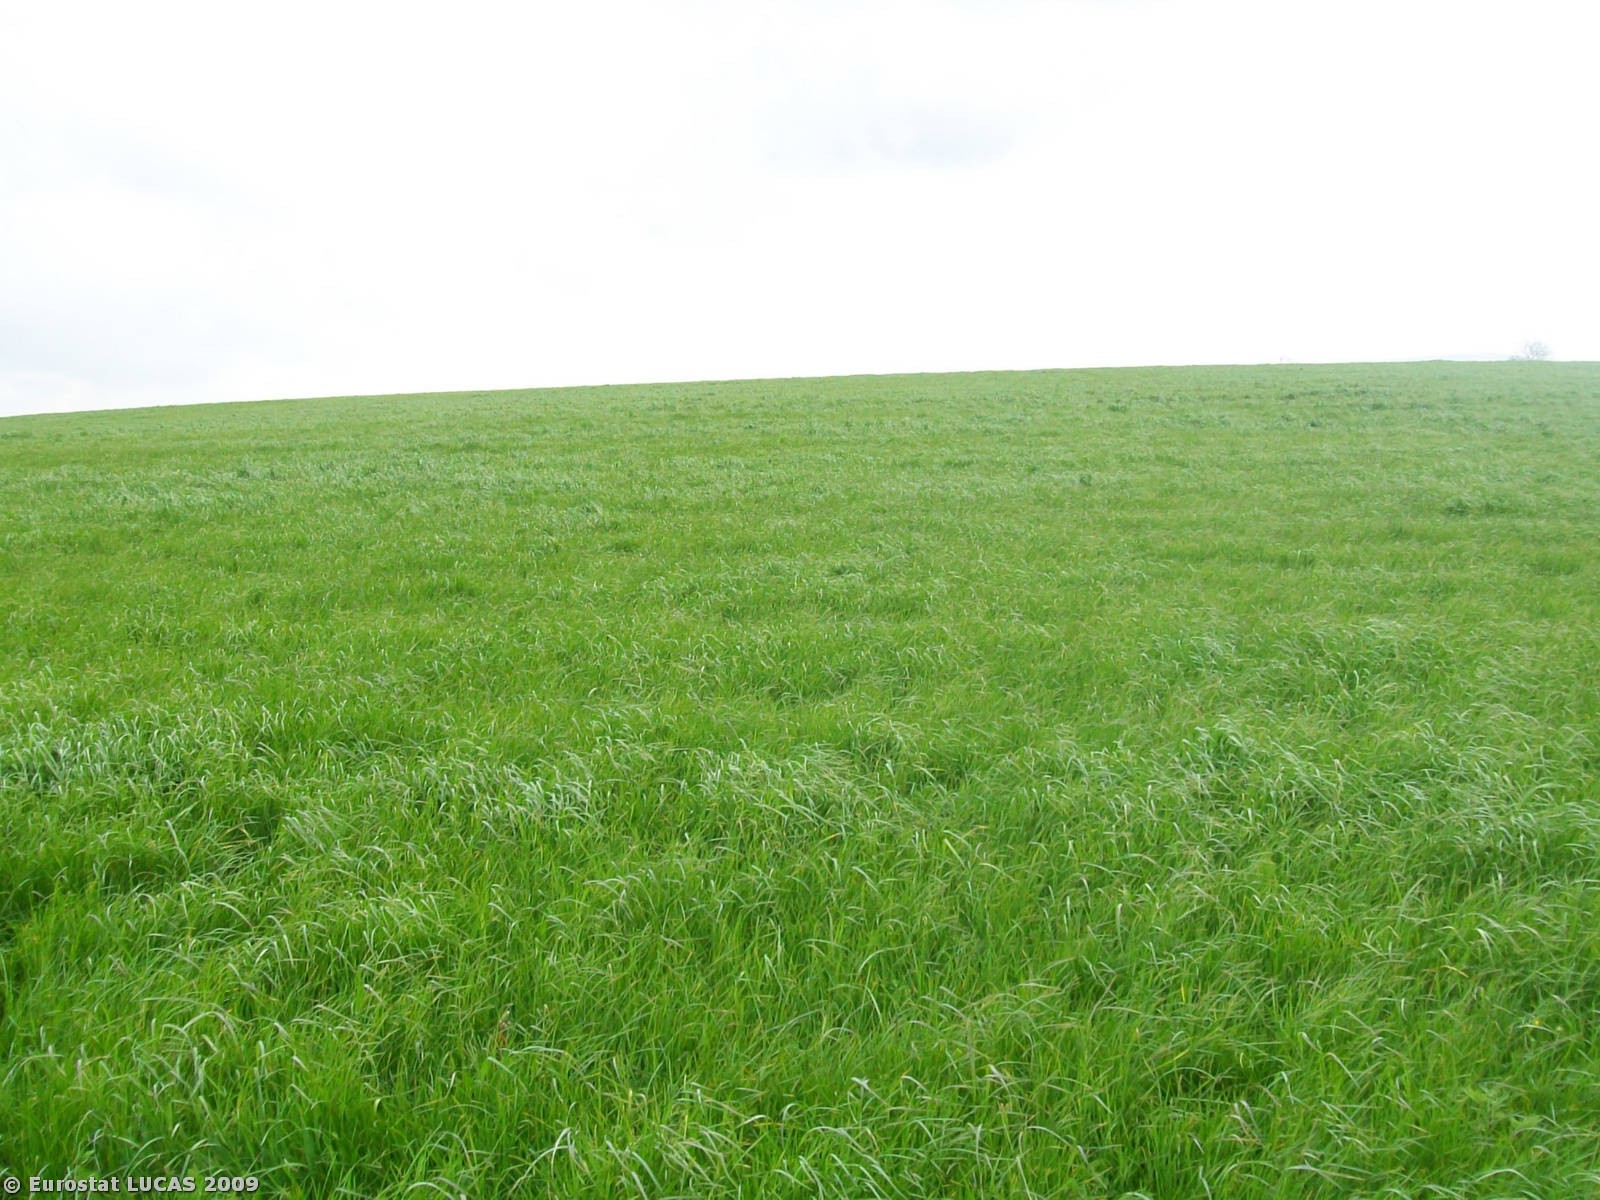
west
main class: Grassland
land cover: Grassland without tree/shrub cover
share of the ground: > 75 %
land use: Agriculture (excluding fallow land and kitchen gardens)
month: May
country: GB
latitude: 50.4835
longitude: -4.2919
